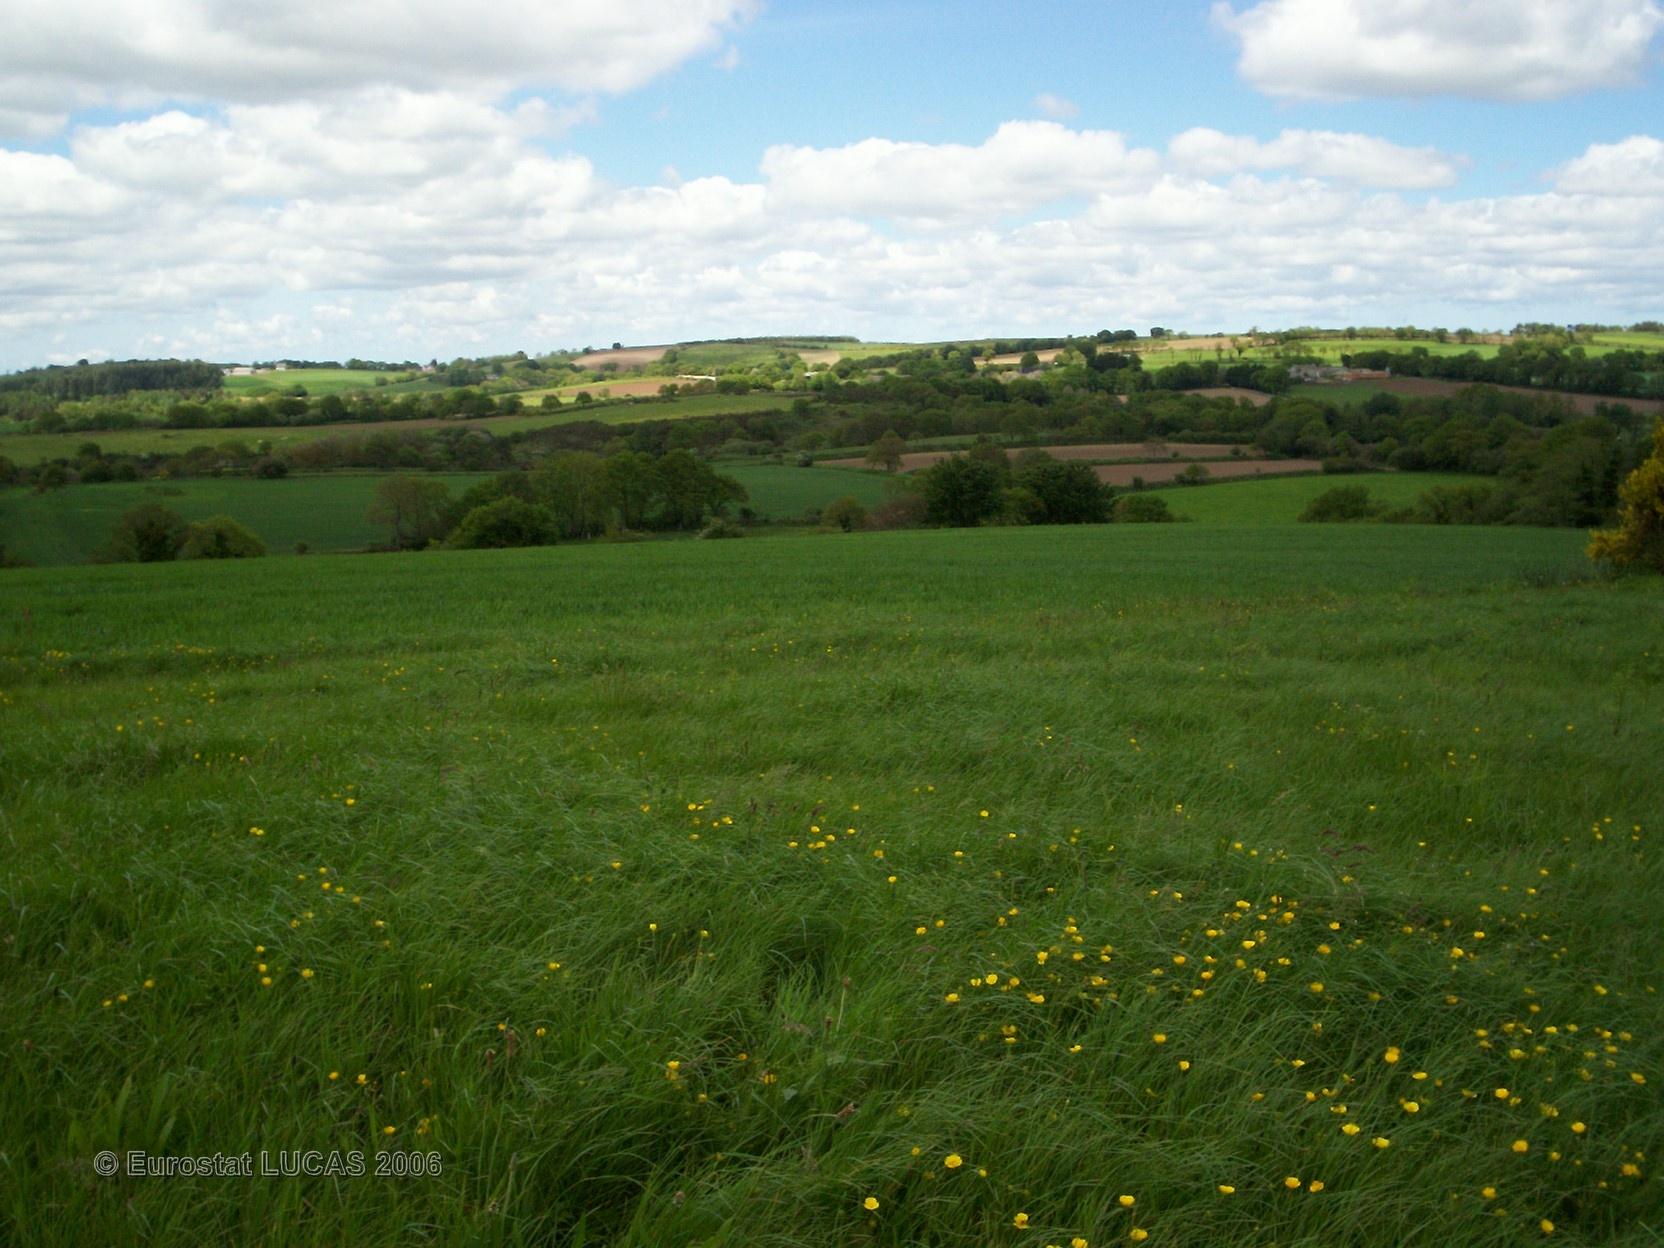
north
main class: Grassland
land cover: Grassland without tree/shrub cover
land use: Agriculture (excluding fallow land and kitchen gardens)
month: May
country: FR
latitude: 48.4125
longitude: -3.0266
